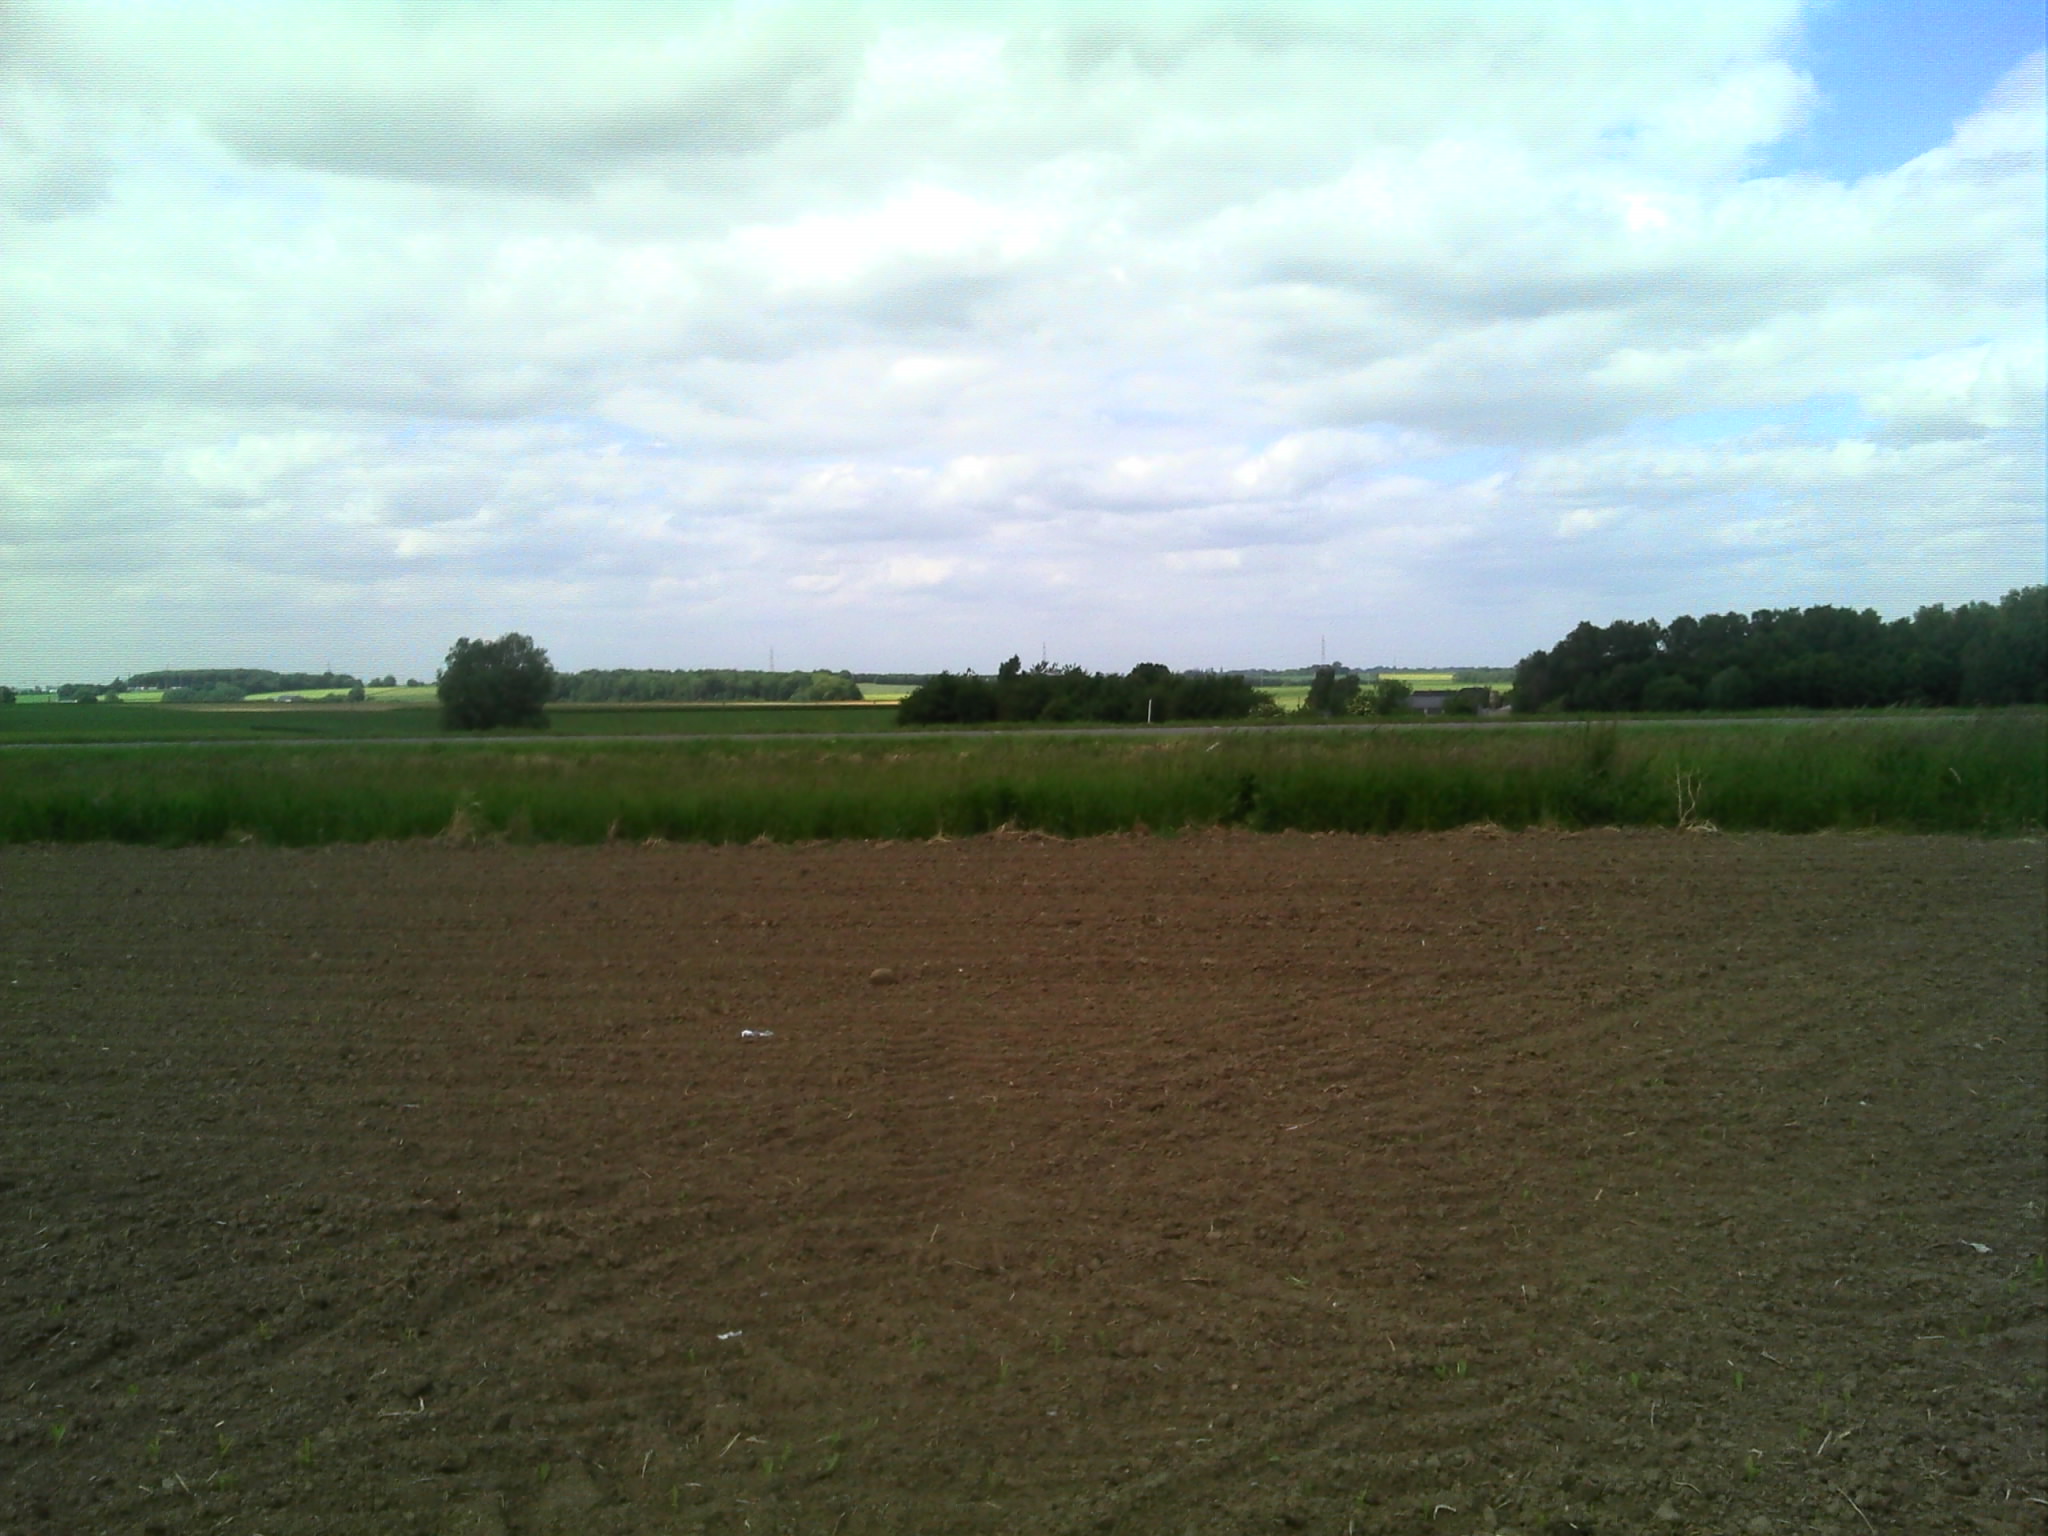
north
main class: Cropland
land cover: Maize
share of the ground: < 10 %
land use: Agriculture (excluding fallow land and kitchen gardens)
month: June
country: BE
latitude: 50.4721
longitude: 4.6279
